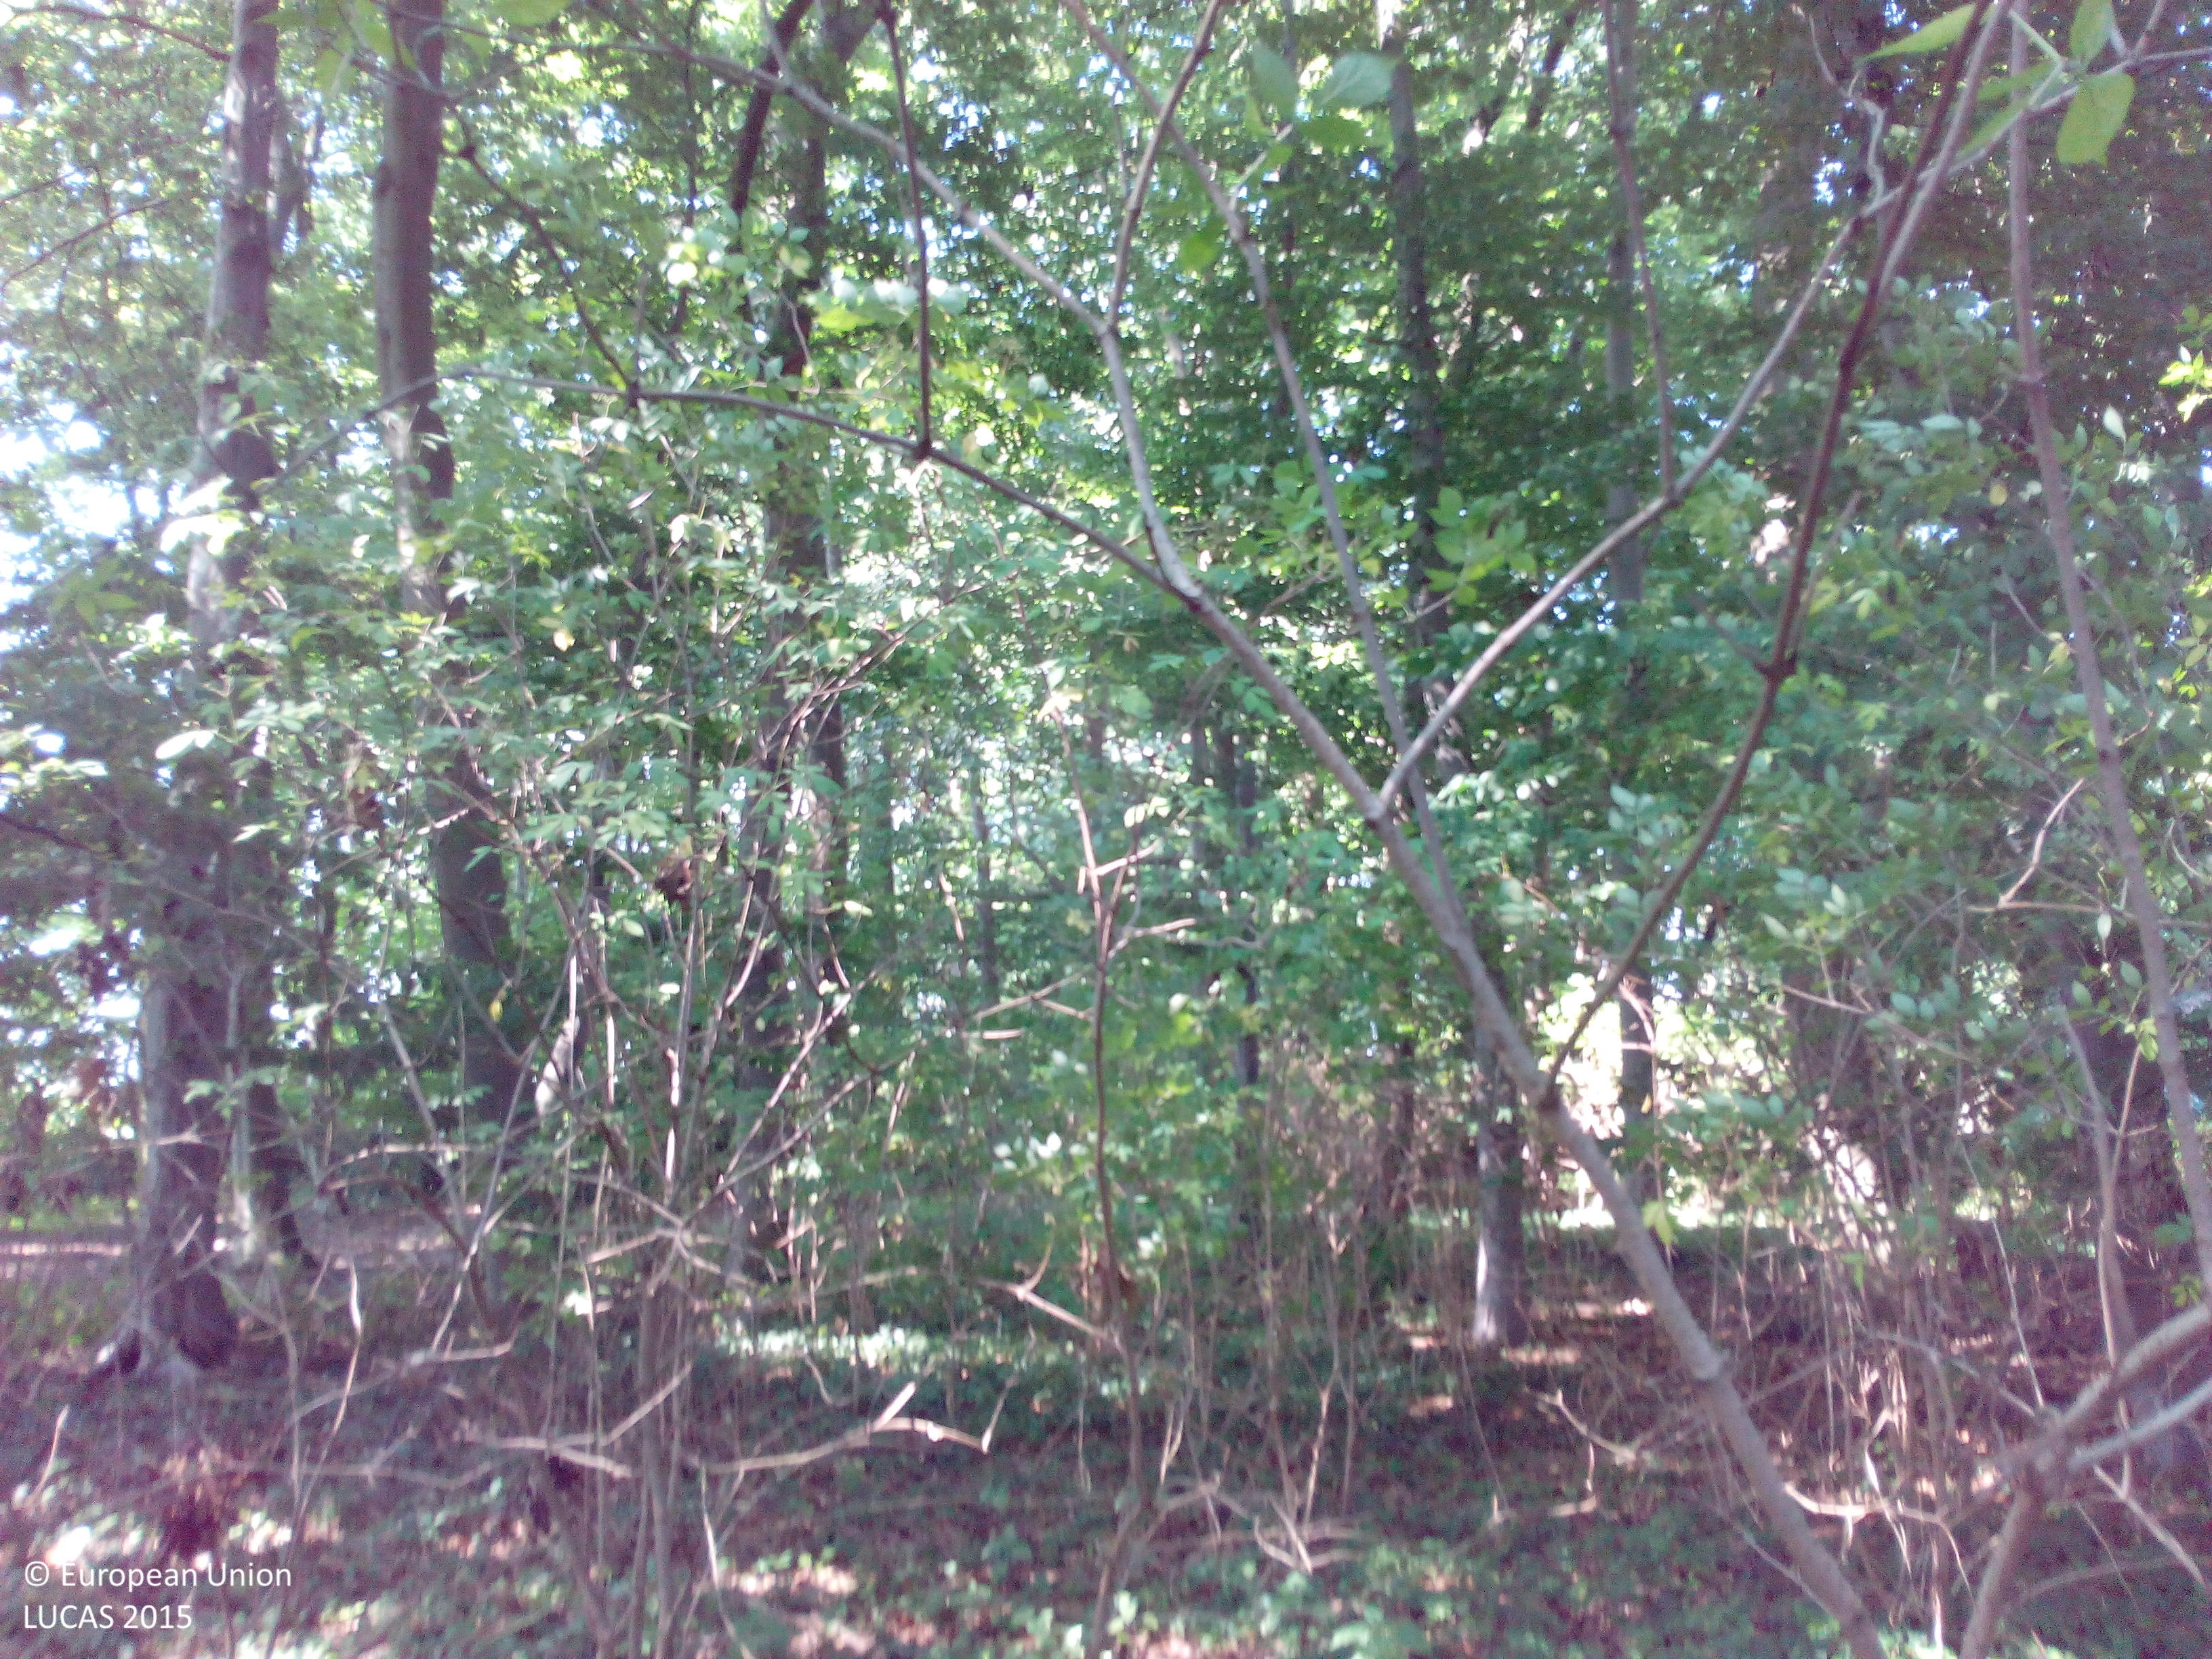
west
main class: Woodland
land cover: Broadleaved woodland
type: mesophytic deciduous forest
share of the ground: > 75 %
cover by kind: broadleaved forest trees 90 %, shrubs 5 %, herbaceous plants 5 %
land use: Forestry
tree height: > 5 m
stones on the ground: < 10 %
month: August
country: DE
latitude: 52.6474
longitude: 7.9460
